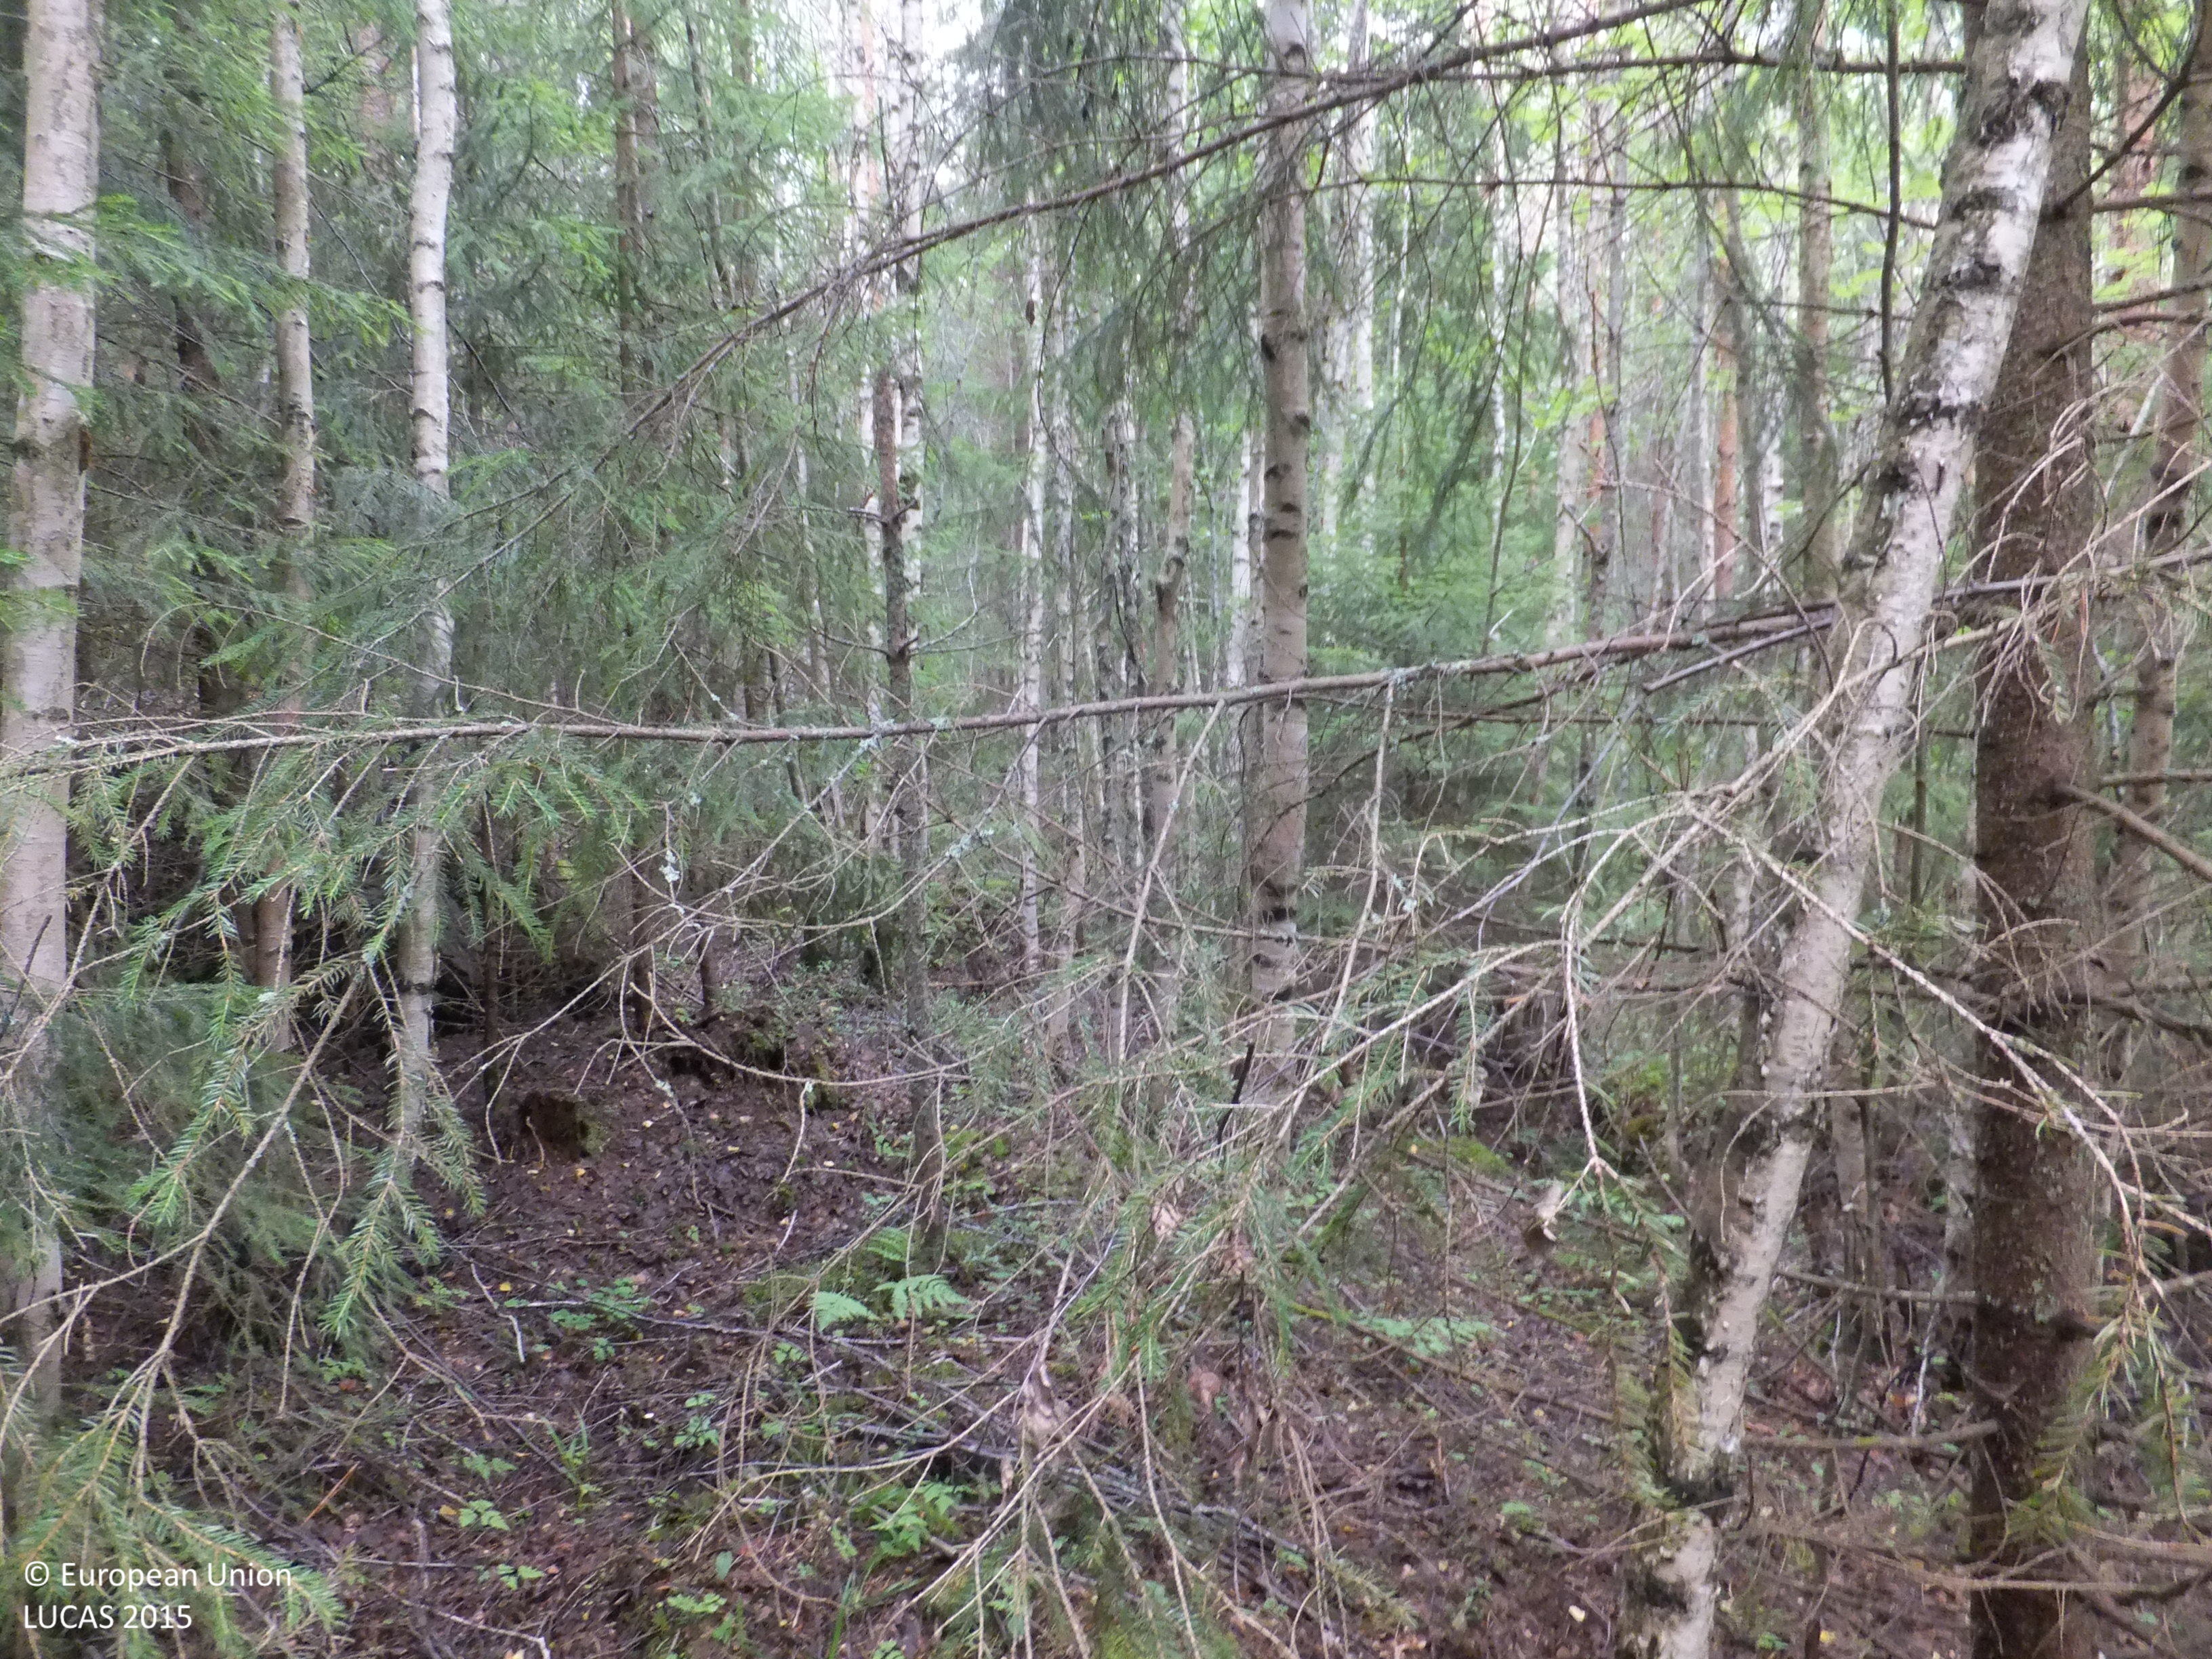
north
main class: Woodland
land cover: Other mixed woodland
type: boreal forest
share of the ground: > 75 %
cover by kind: broadleaved forest trees 45 %, coniferous forest trees 40 %, shrubs 5 %, herbaceous plants 5 %, lichens and mosses 5 %
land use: Forestry
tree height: > 5 m
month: July
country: FI
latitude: 63.0387
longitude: 21.6057
